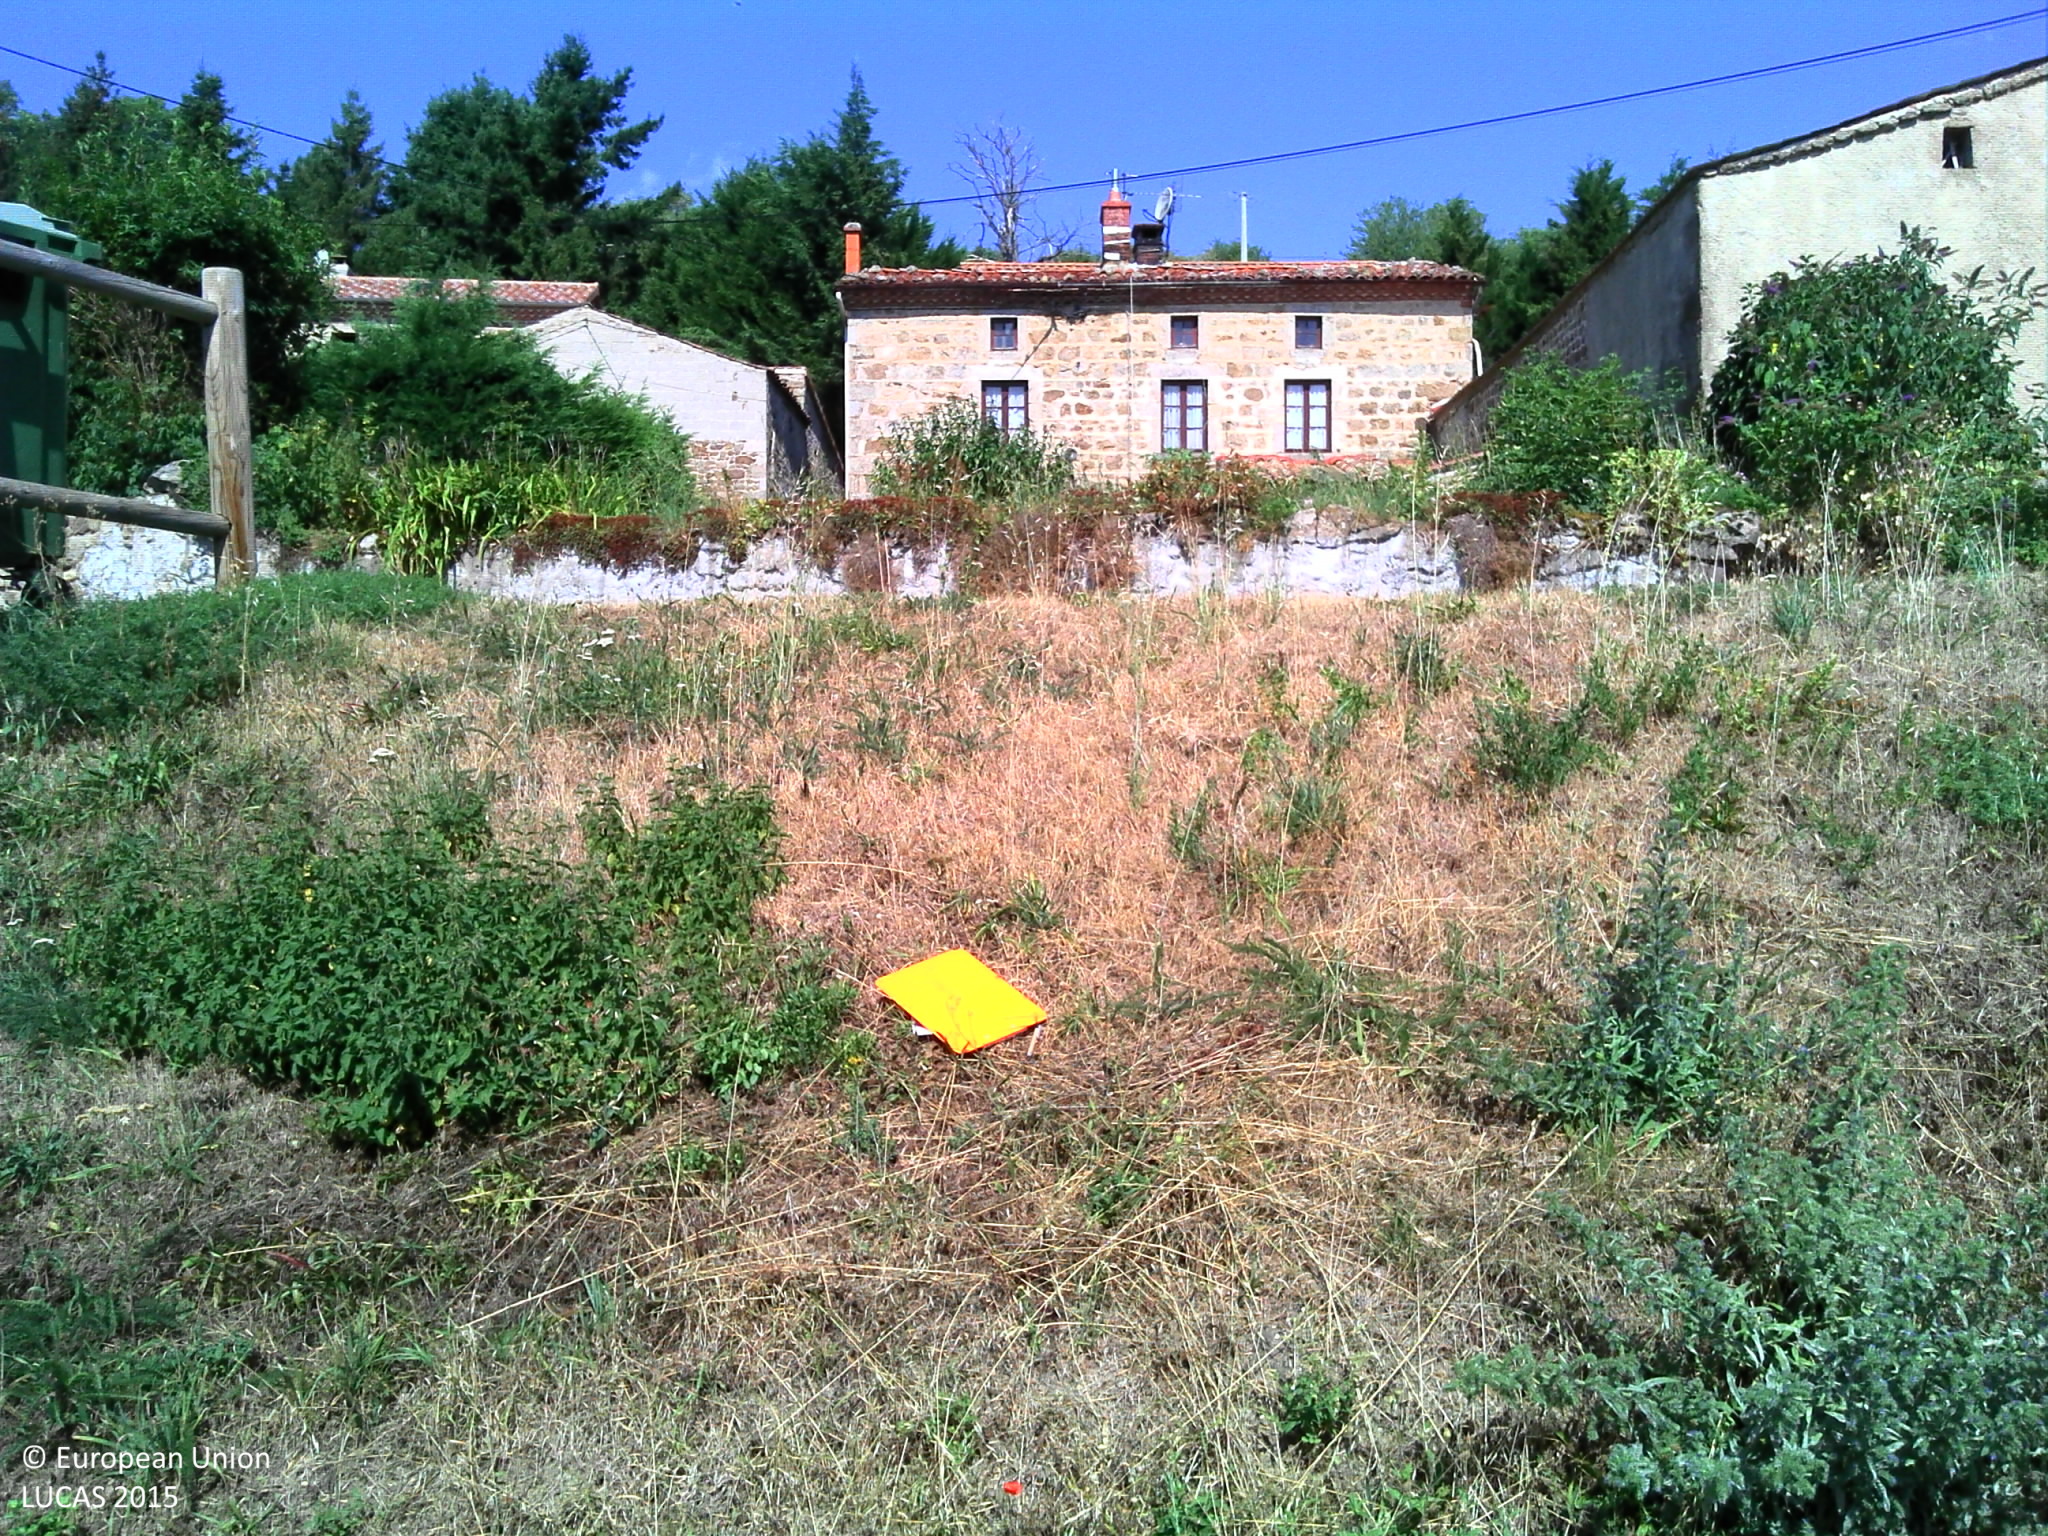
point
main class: Grassland
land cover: Grassland without tree/shrub cover
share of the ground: > 75 %
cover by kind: herbaceous plants 95 %, unconsolidated bare surface 5 %
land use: Semi-natural and natural areas not in use
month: August
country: FR
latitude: 45.3484
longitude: 4.6054
